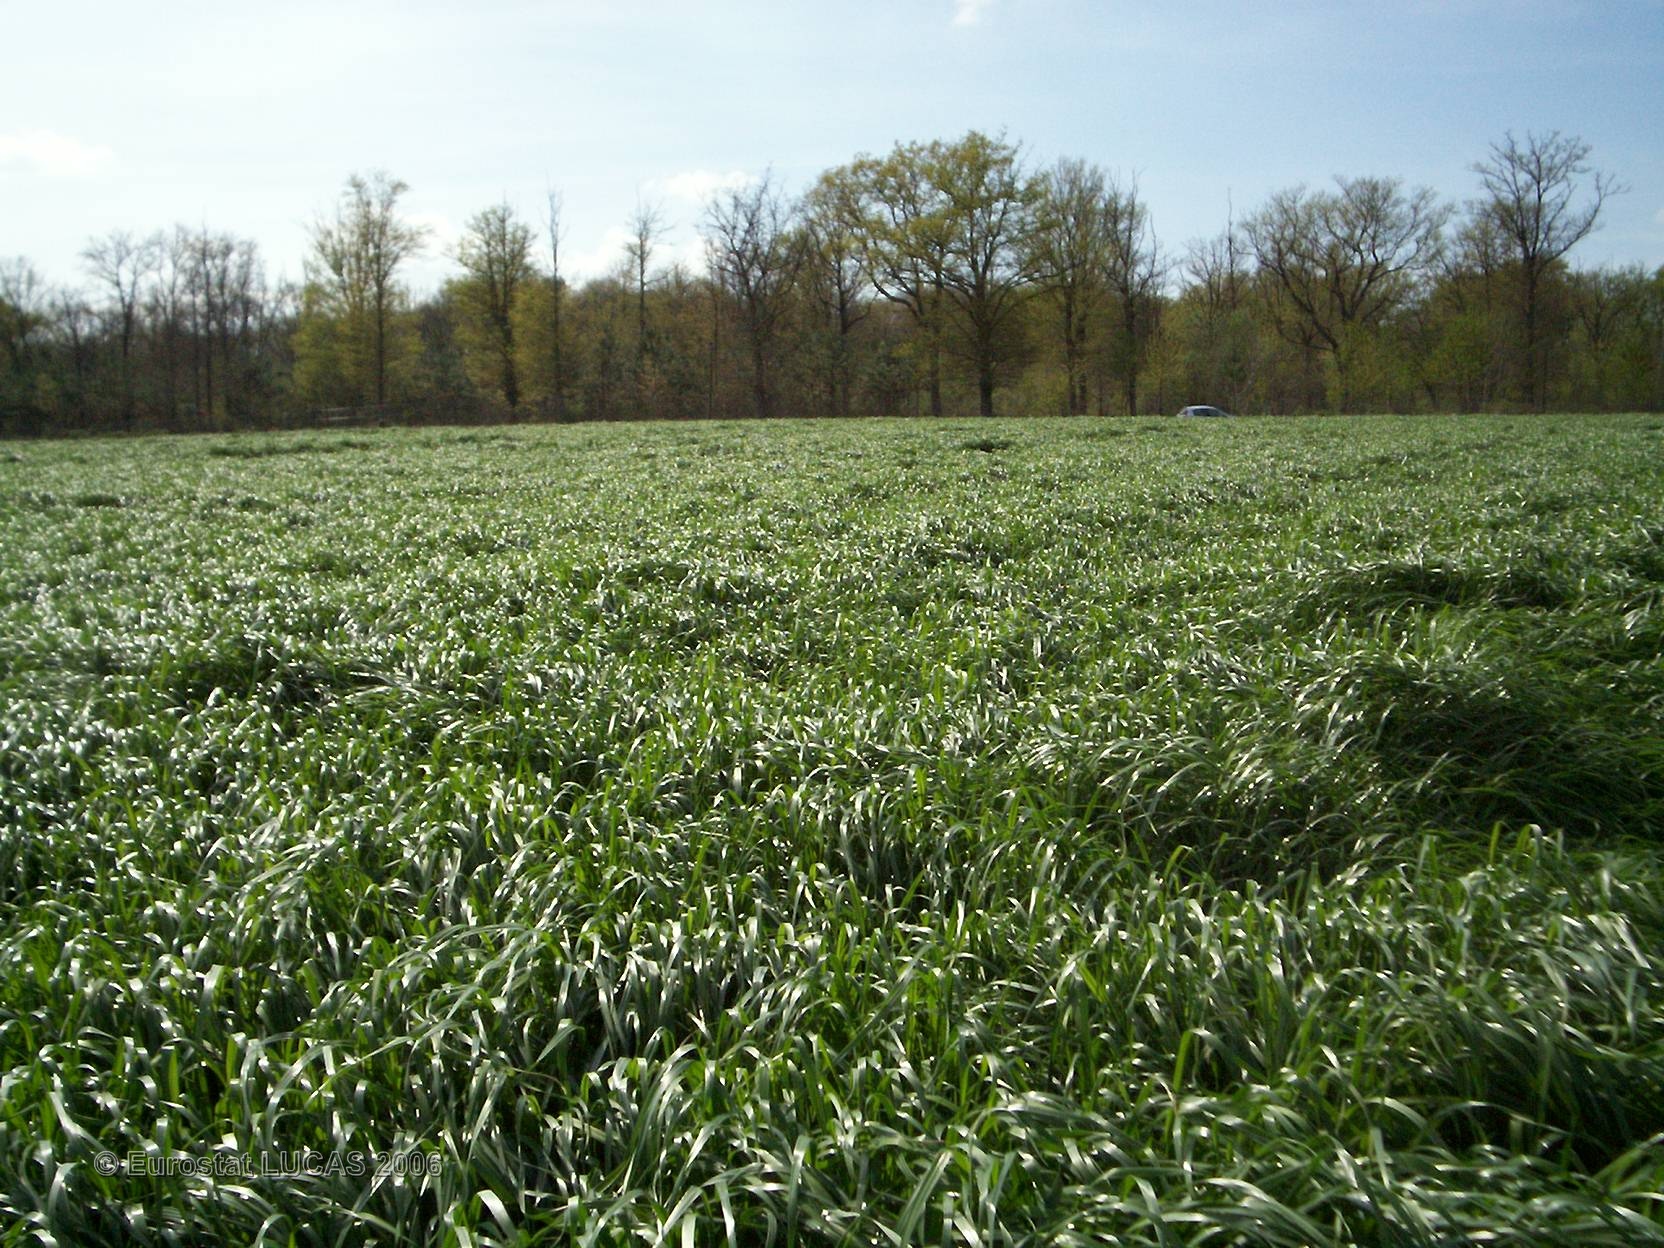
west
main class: Grassland
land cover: Grassland without tree/shrub cover
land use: Agriculture (excluding fallow land and kitchen gardens)
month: April
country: FR
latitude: 46.9256
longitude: 0.5120
